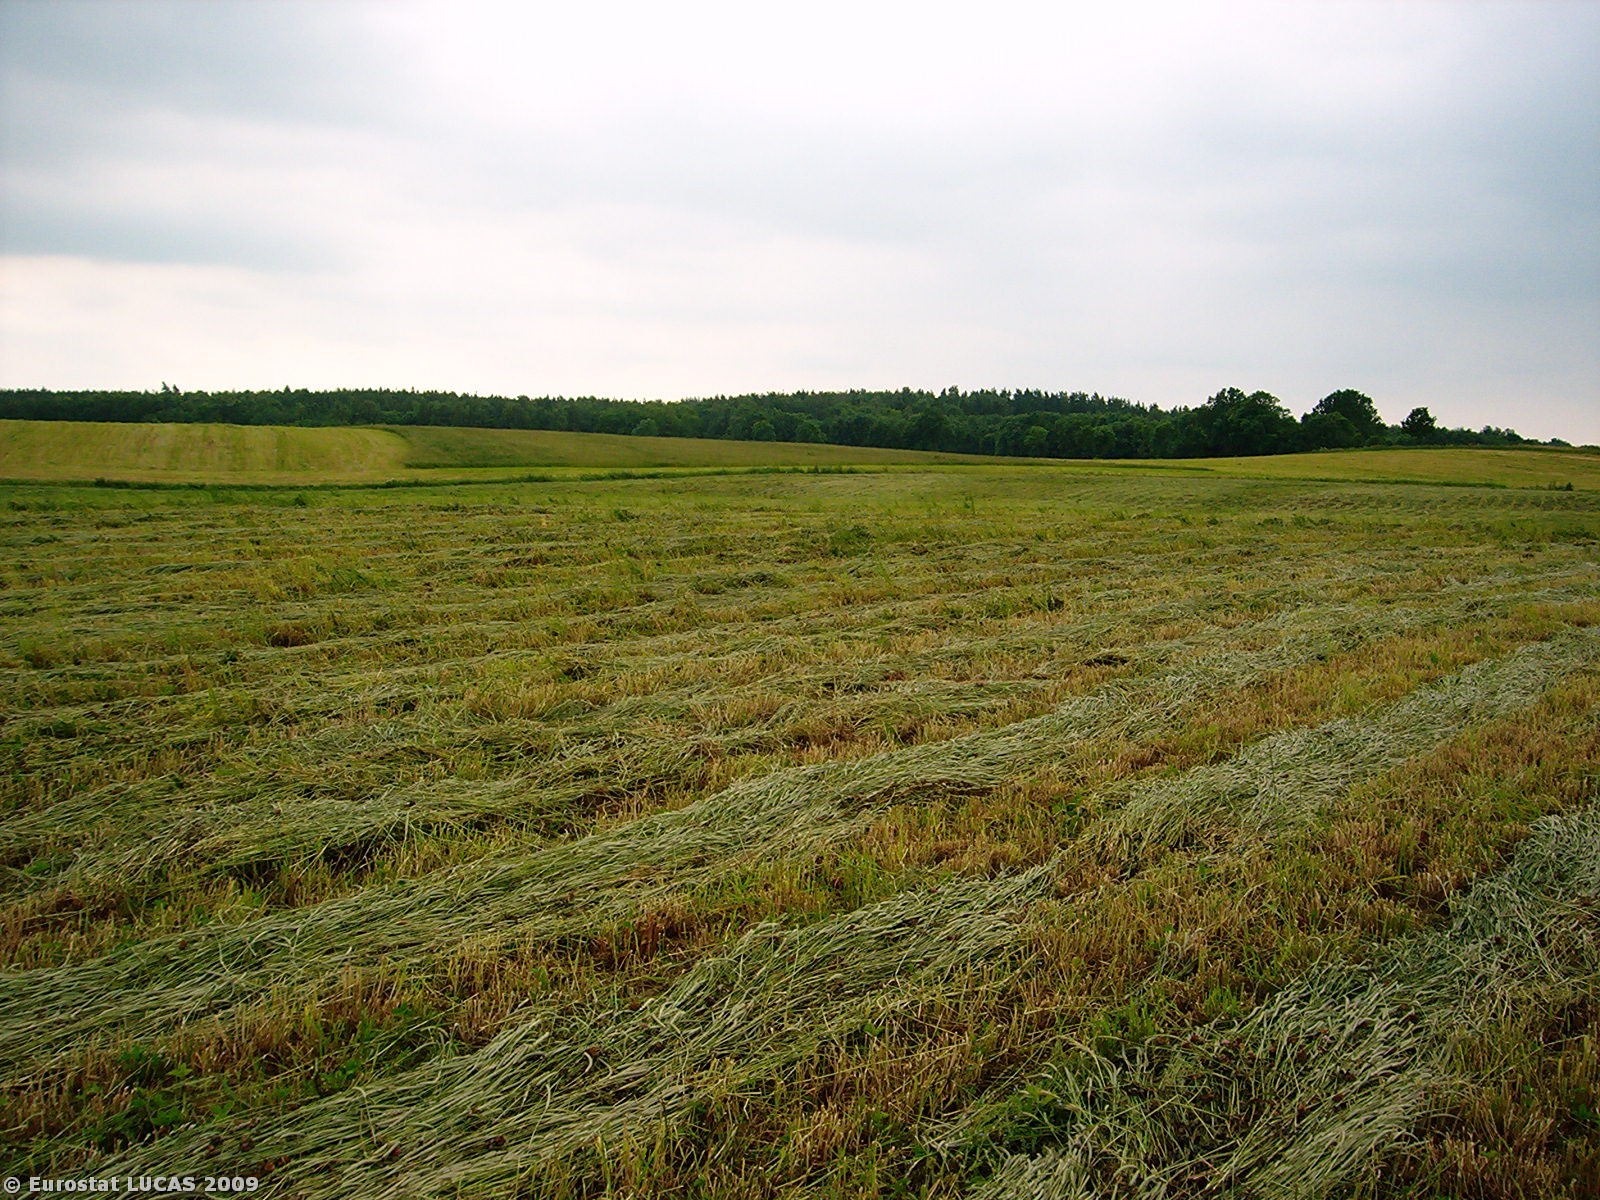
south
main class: Cropland
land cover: Clovers
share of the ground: > 75 %
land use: Agriculture (excluding fallow land and kitchen gardens)
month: June
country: PL
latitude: 53.0631
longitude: 15.4502
